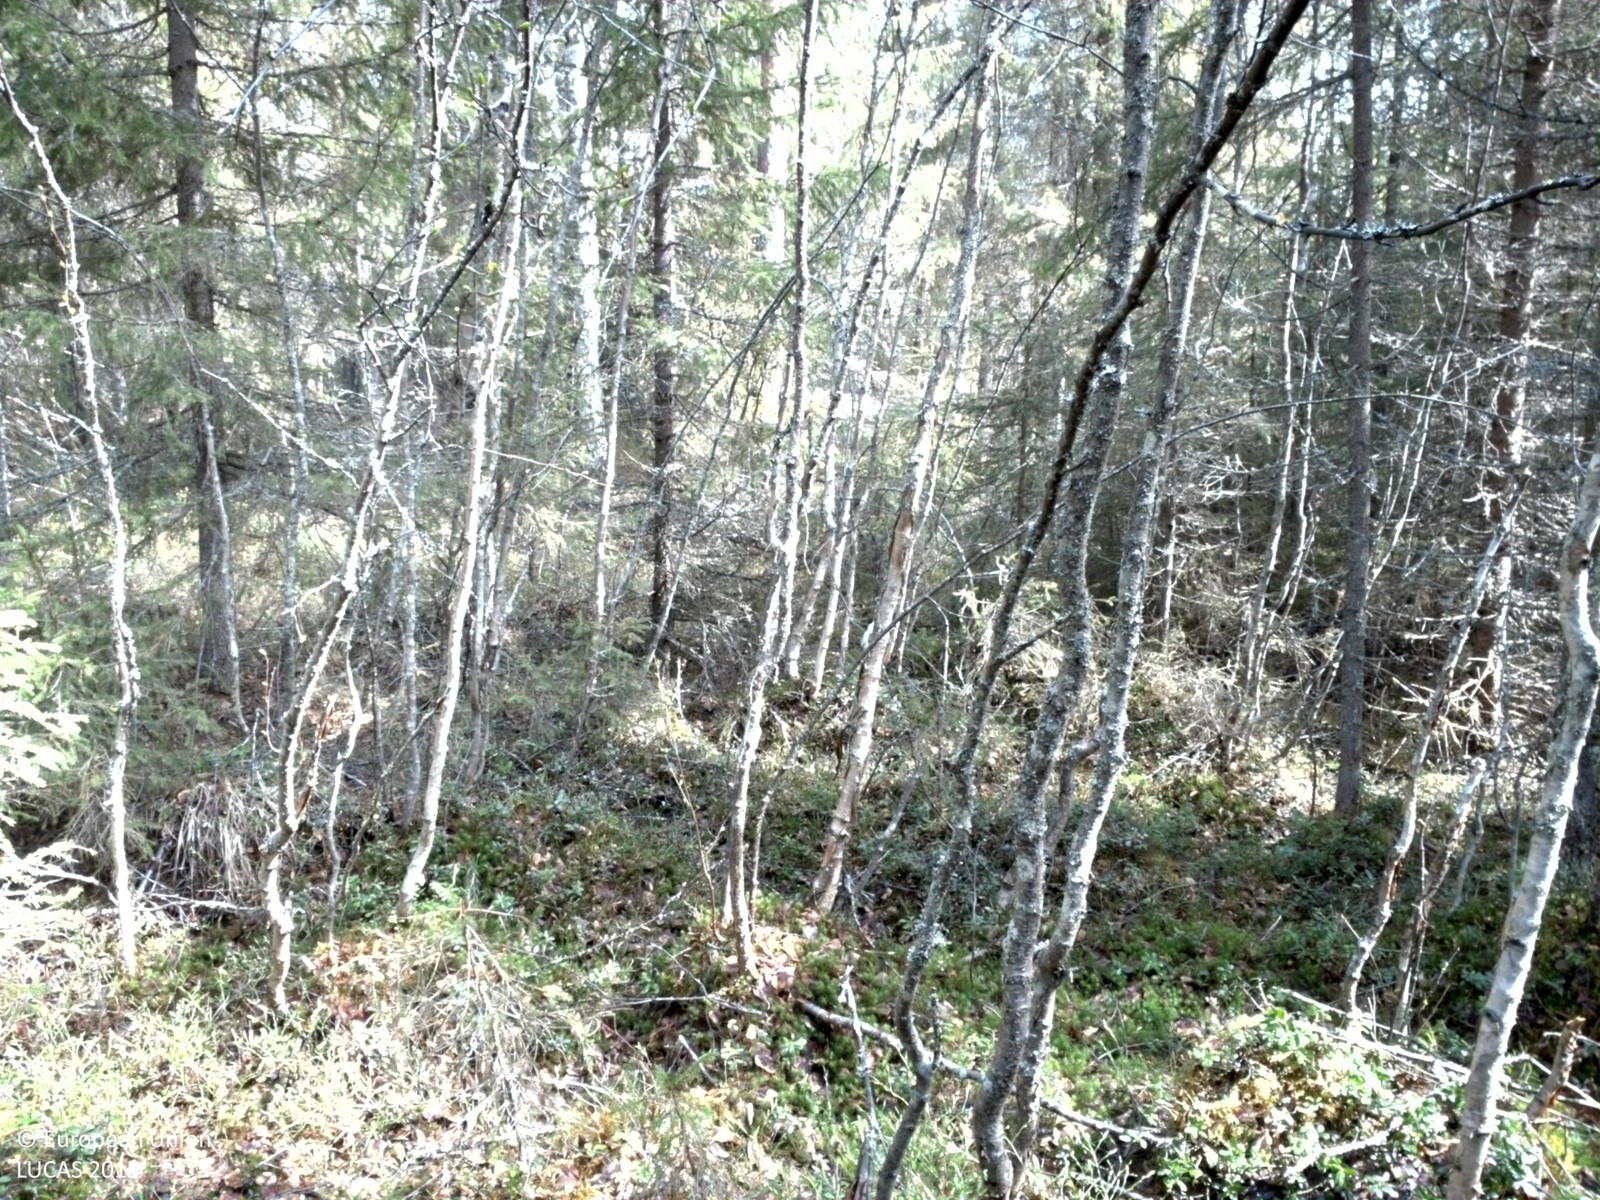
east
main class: Woodland
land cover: Other mixed woodland
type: boreal forest
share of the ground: > 75 %
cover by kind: coniferous forest trees 60 %, broadleaved forest trees 25 %, shrubs 10 %, lichens and mosses 5 %
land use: Forestry
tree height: > 5 m
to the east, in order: Other mixed woodland; Pine dominated coniferous woodland; Ditches and canals; Broadleaved woodland; Ditches and canals; Broadleaved woodland; Ditches and canals; Broadleaved woodland; Ditches and canals; Broadleaved woodland; Ditches and canals; Broadleaved woodland; Ditches and canals; Spruce dominated coniferous woodland; Broadleaved woodland; Spruce dominated mixed woodland; Broadleaved woodland; Ditches and canals; Broadleaved woodland; Pine dominated coniferous woodland; Spruce dominated coniferous woodland; Ditches and canals; Grassland without tree/shrub cover; Broadleaved woodland
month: June
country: SE
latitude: 65.9817
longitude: 23.1306
